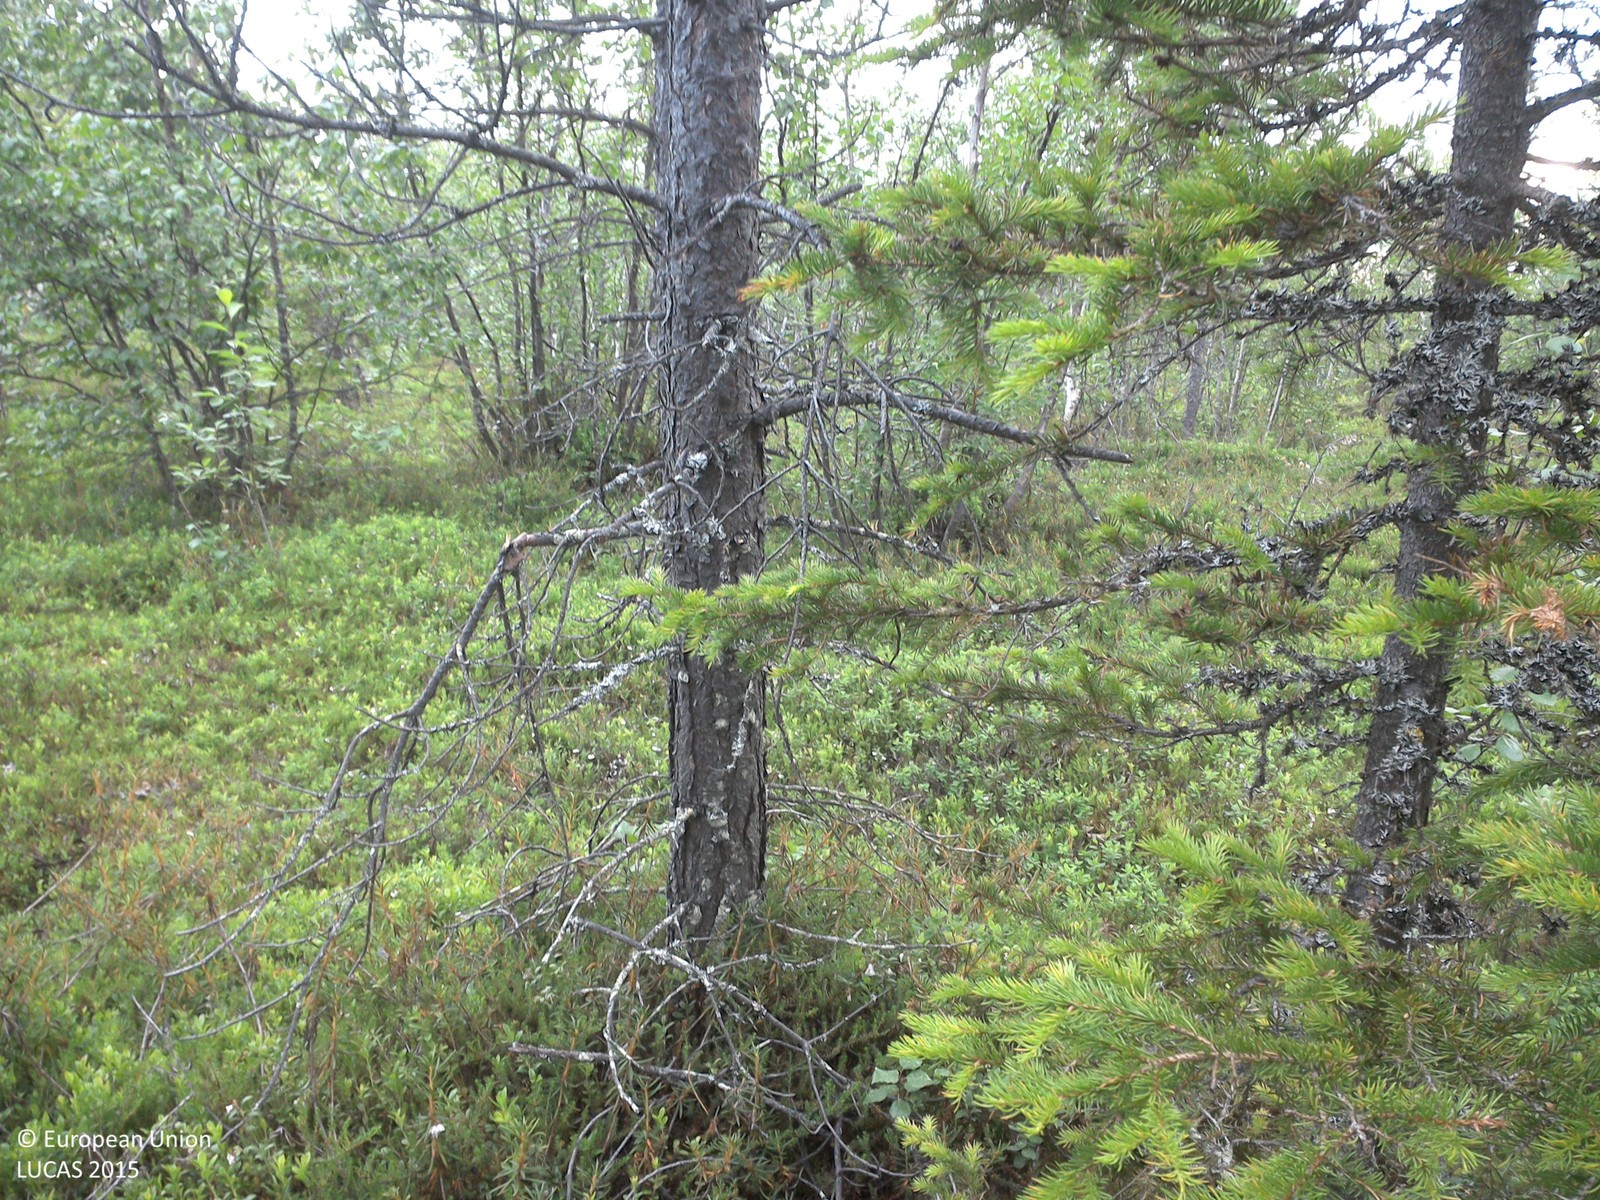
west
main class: Woodland
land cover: Pine dominated mixed woodland
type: boreal forest
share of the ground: 25 - 50 %
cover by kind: shrubs 60 %, coniferous forest trees 20 %, broadleaved forest trees 15 %, lichens and mosses 5 %
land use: Forestry
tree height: > 5 m
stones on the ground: < 10 %
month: July
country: SE
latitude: 67.8061
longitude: 22.3589
